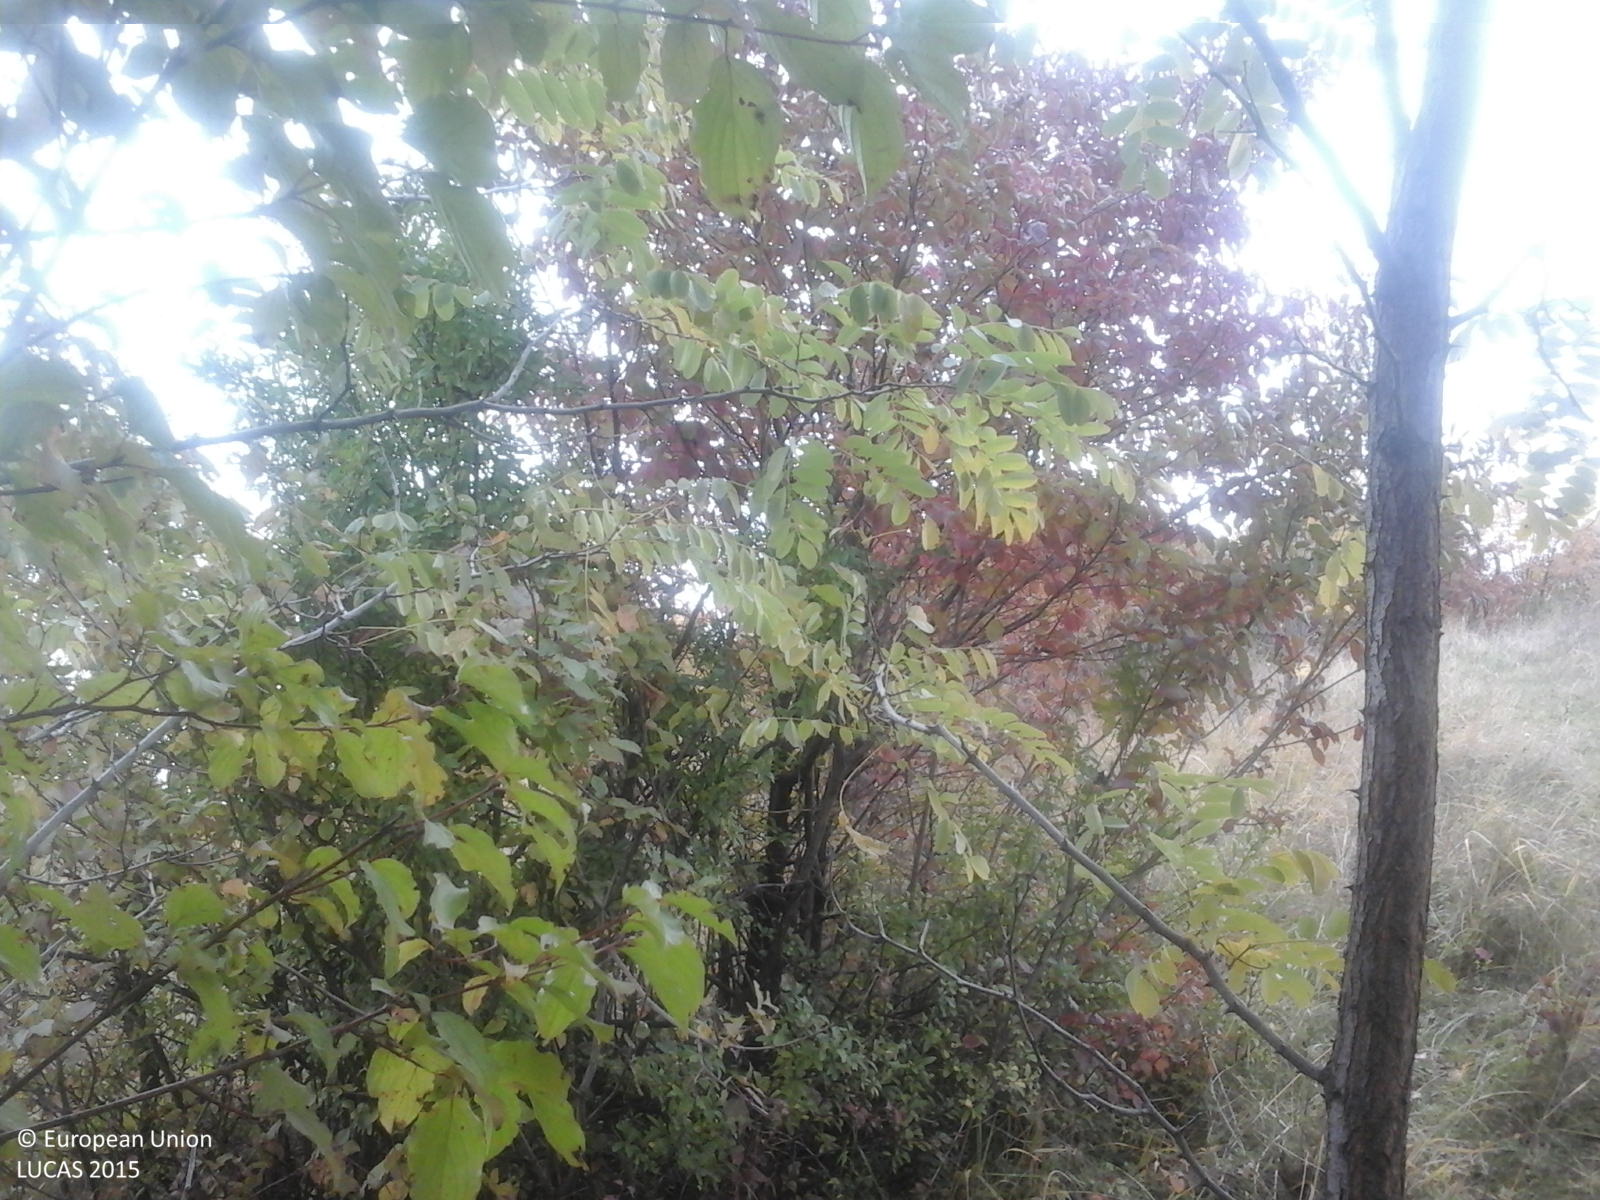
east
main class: Woodland
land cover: Broadleaved woodland
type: exotic forest
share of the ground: > 75 %
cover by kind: broadleaved forest trees 100 %
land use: Forestry
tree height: > 5 m
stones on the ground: < 10 %
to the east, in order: Broadleaved woodland; Grassland with sparse tree/shrub cover; Broadleaved woodland; Tracks; Broadleaved woodland
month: October
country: RO
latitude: 45.0388
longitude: 26.0411
